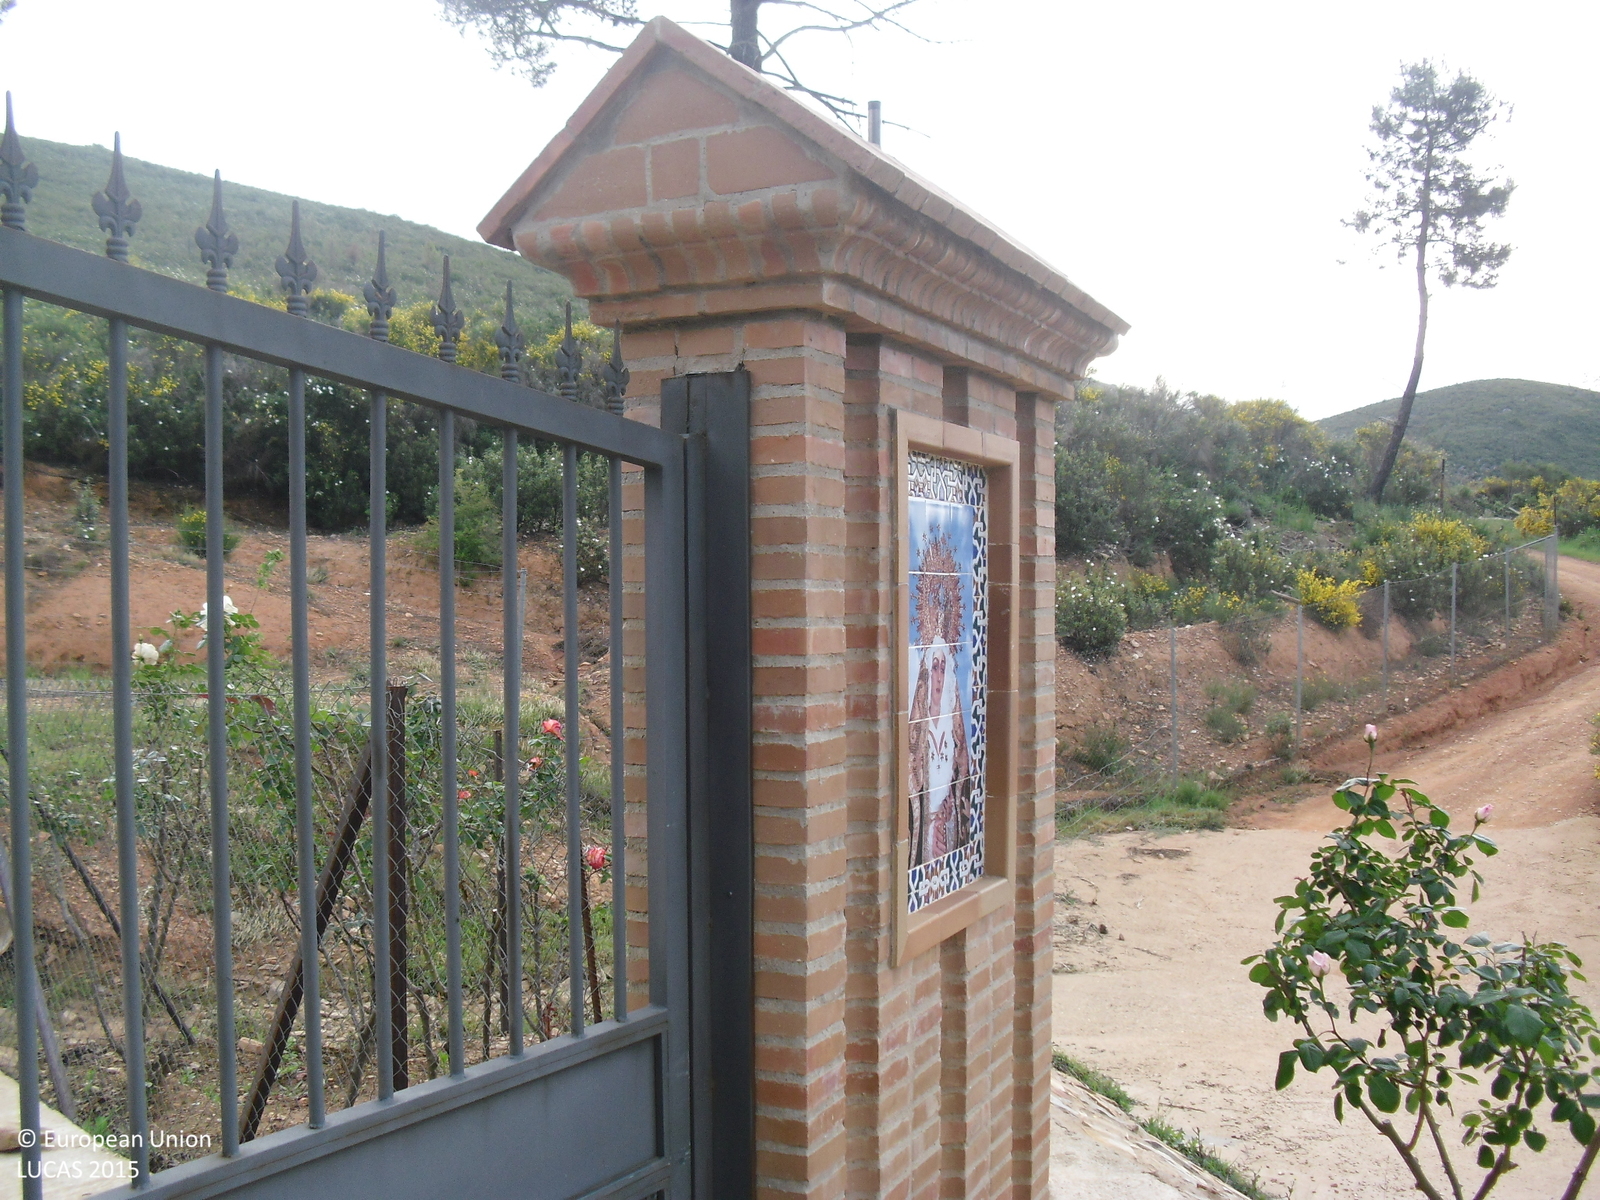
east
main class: Woodland
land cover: Broadleaved woodland
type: thermophilous deciduous forest
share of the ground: 10 - 25 %
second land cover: Grassland without tree/shrub cover
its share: > 75 %
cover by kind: herbaceous plants 80 %, broadleaved forest trees 15 %, shrubs 5 %
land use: Forestry
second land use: Agriculture (excluding fallow land and kitchen gardens)
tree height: > 5 m
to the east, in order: Broadleaved woodland; Grassland without tree/shrub cover; Other structural elements; Fences; Broadleaved woodland
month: May
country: ES
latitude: 39.4160
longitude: -5.3685
